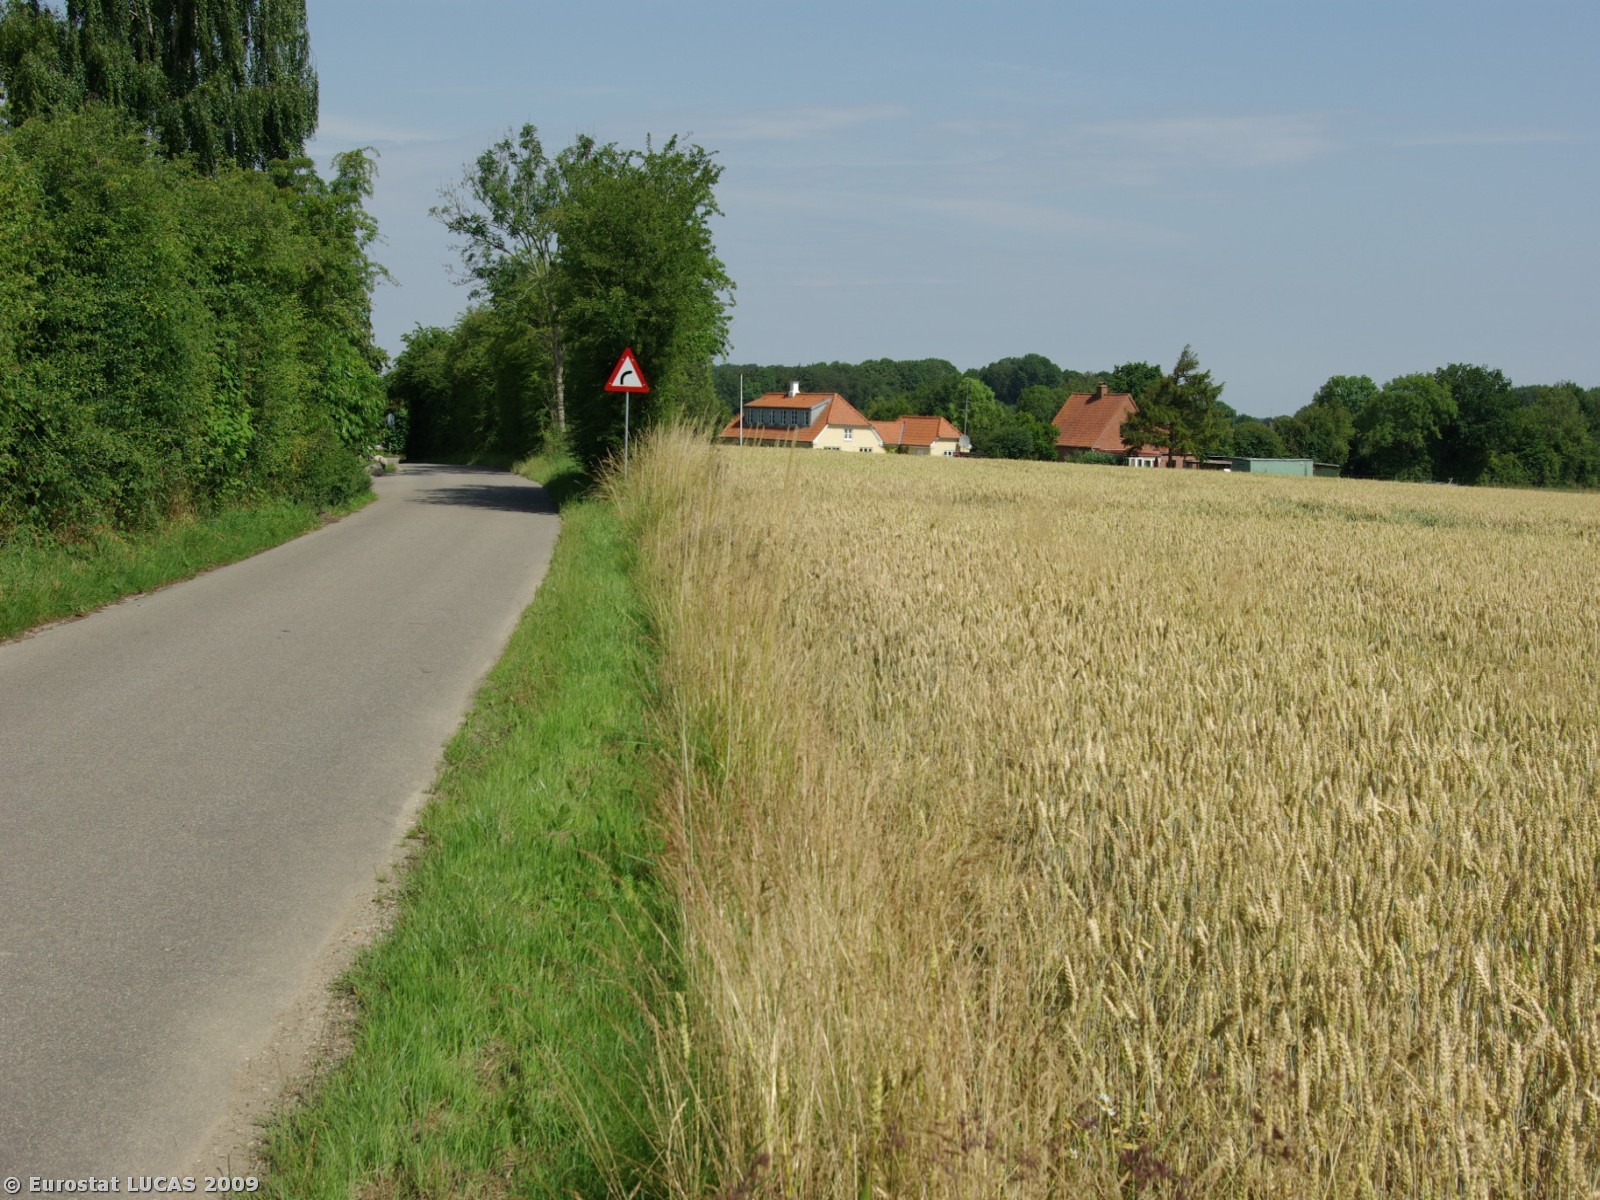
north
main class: Cropland
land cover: Common wheat
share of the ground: > 75 %
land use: Agriculture (excluding fallow land and kitchen gardens)
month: July
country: DK
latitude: 54.9652
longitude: 9.7347
